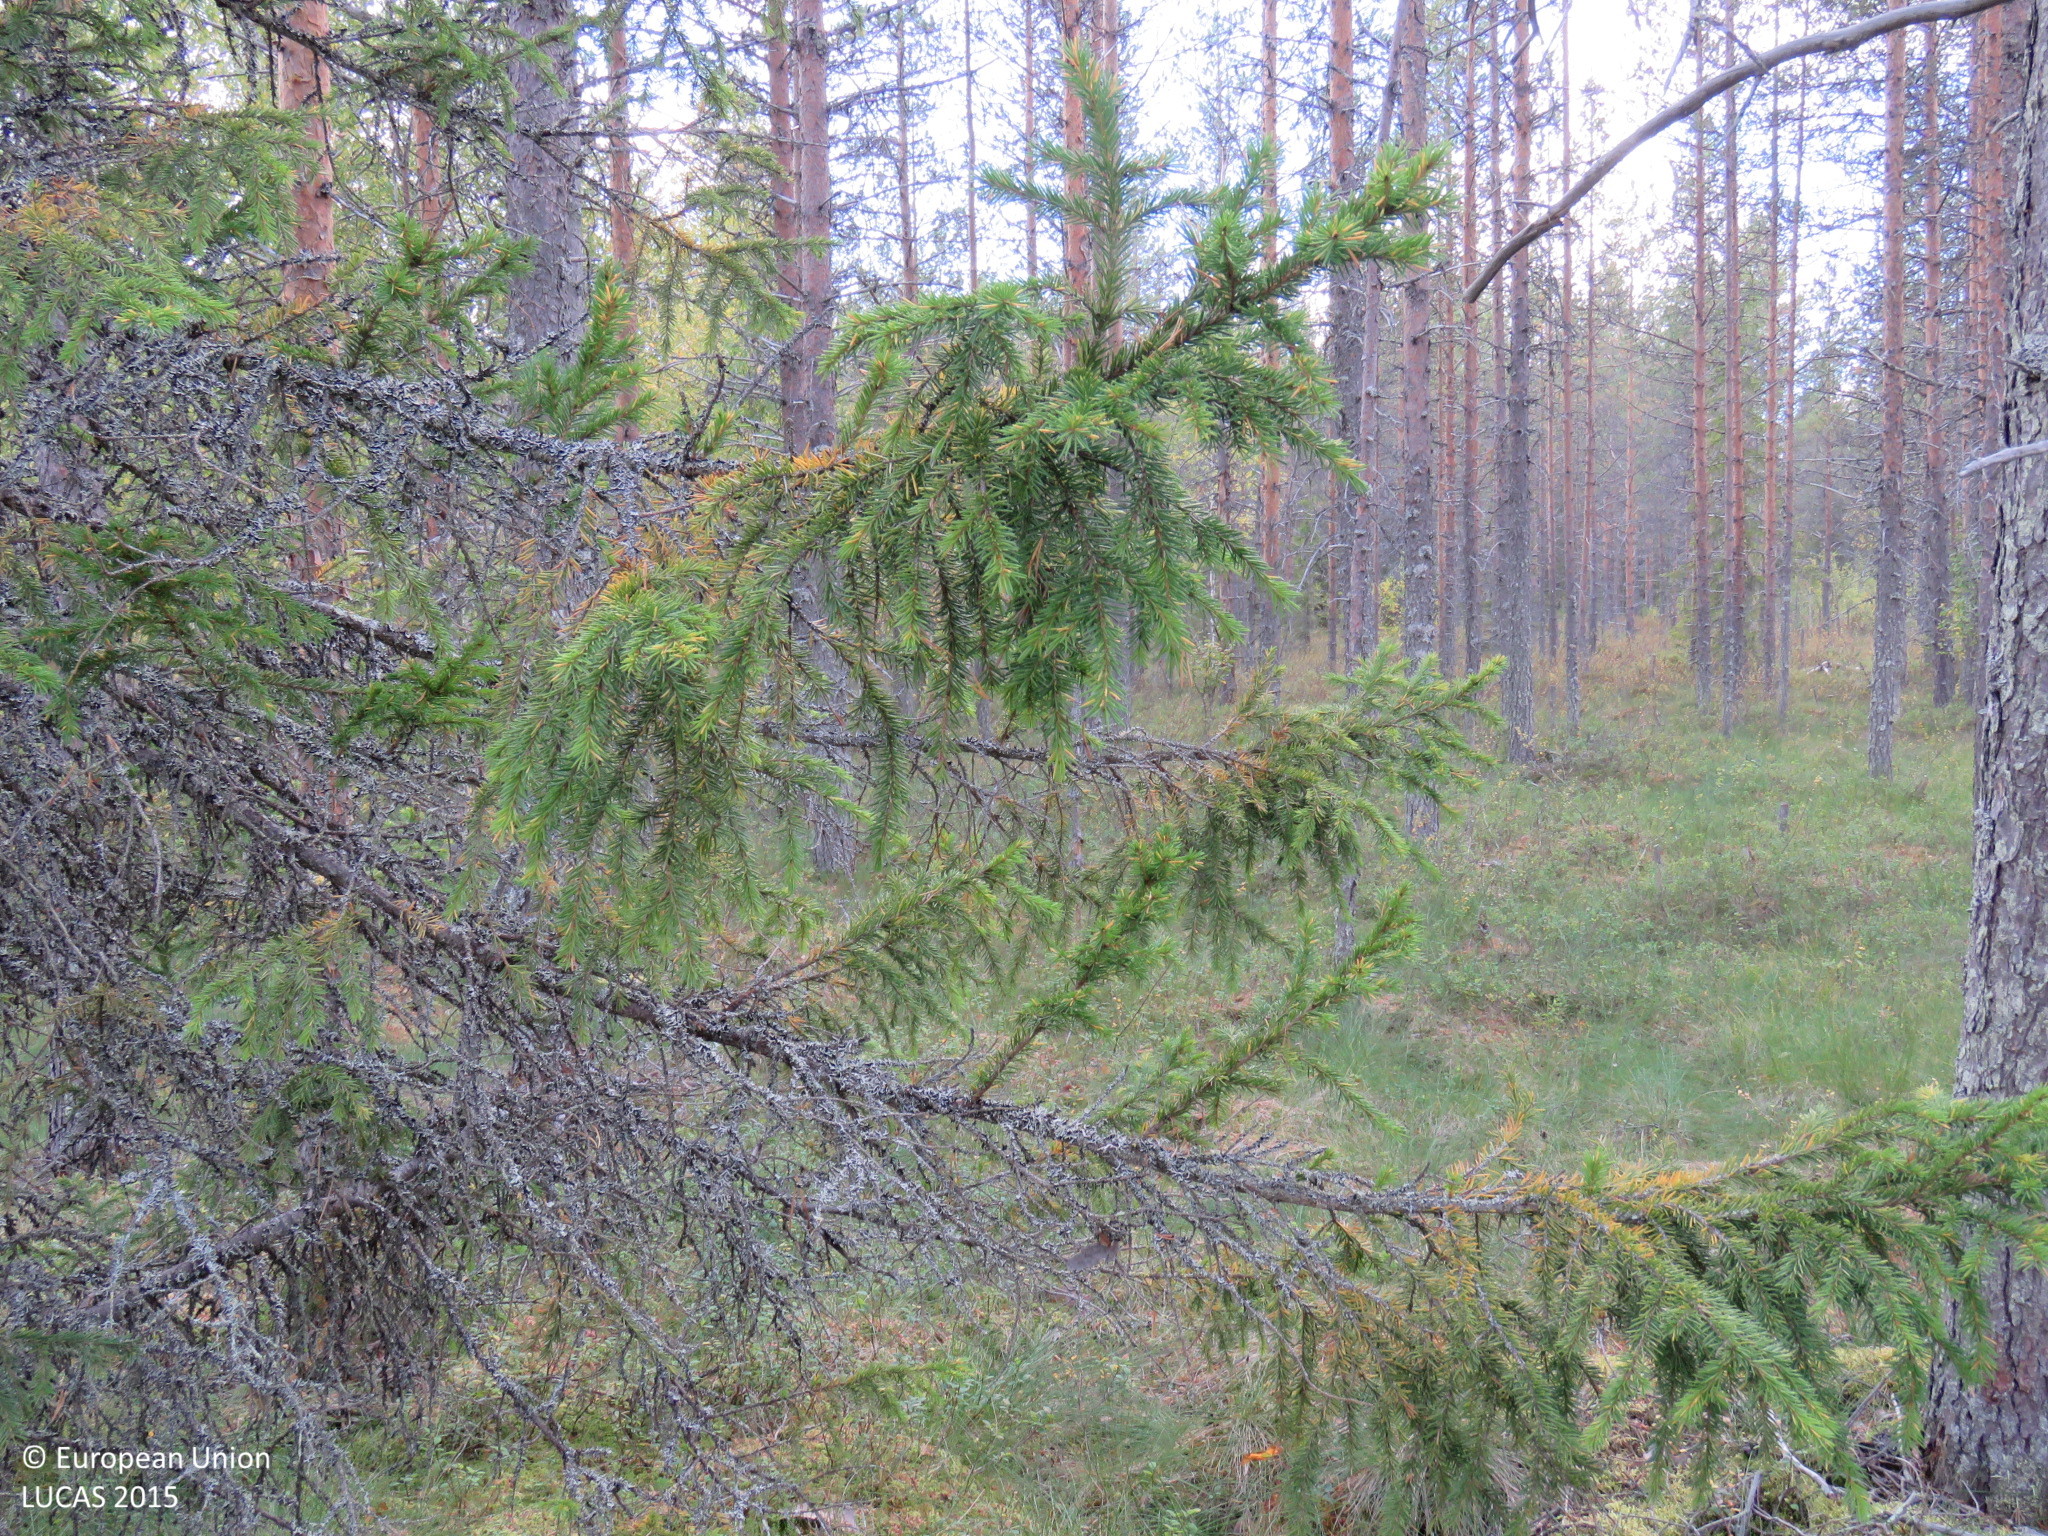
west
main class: Woodland
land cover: Pine dominated coniferous woodland
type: mire and swamp forests
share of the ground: > 75 %
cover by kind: coniferous forest trees 65 %, herbaceous plants 15 %, broadleaved forest trees 10 %, shrubs 5 %, lichens and mosses 5 %
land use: Forestry
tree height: > 5 m
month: September
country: FI
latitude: 65.3740
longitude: 27.6206
